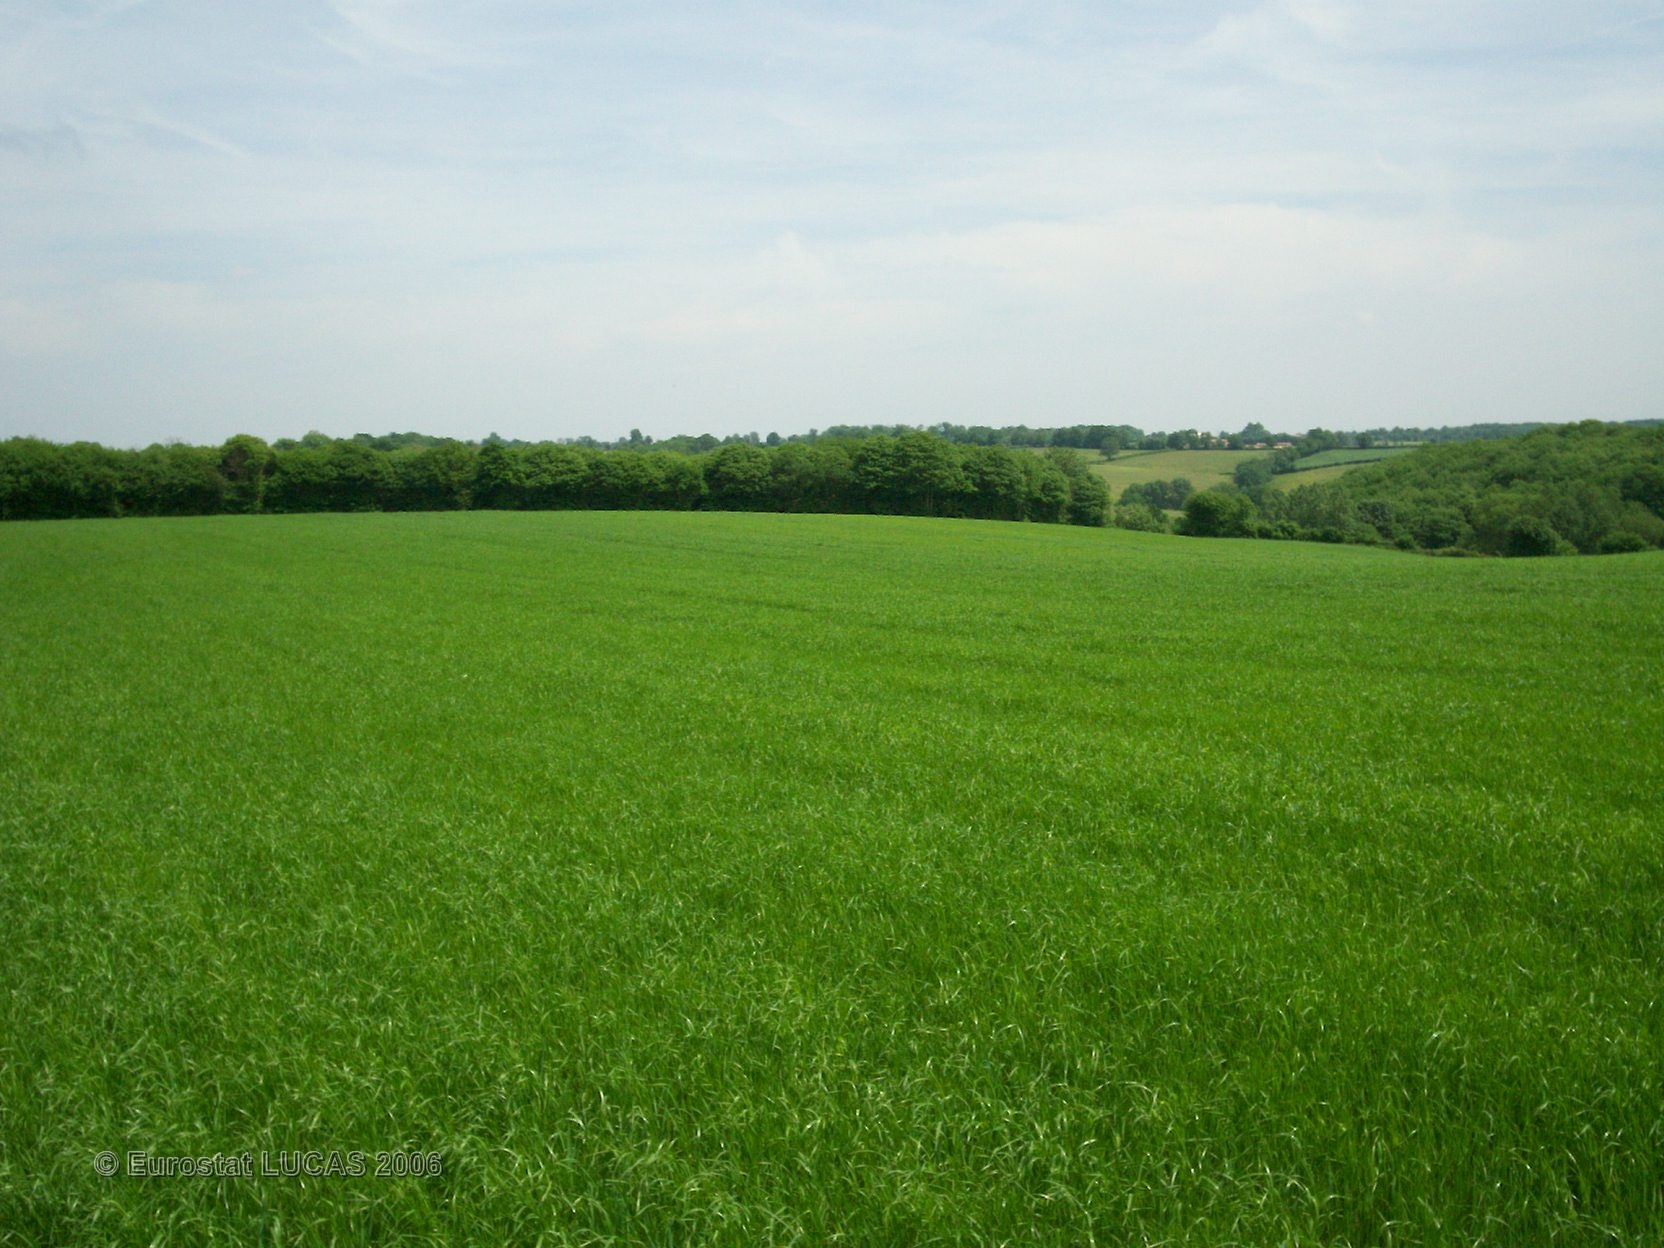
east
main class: Grassland
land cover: Grassland without tree/shrub cover
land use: Agriculture (excluding fallow land and kitchen gardens)
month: May
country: FR
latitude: 46.4876
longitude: -0.3030
